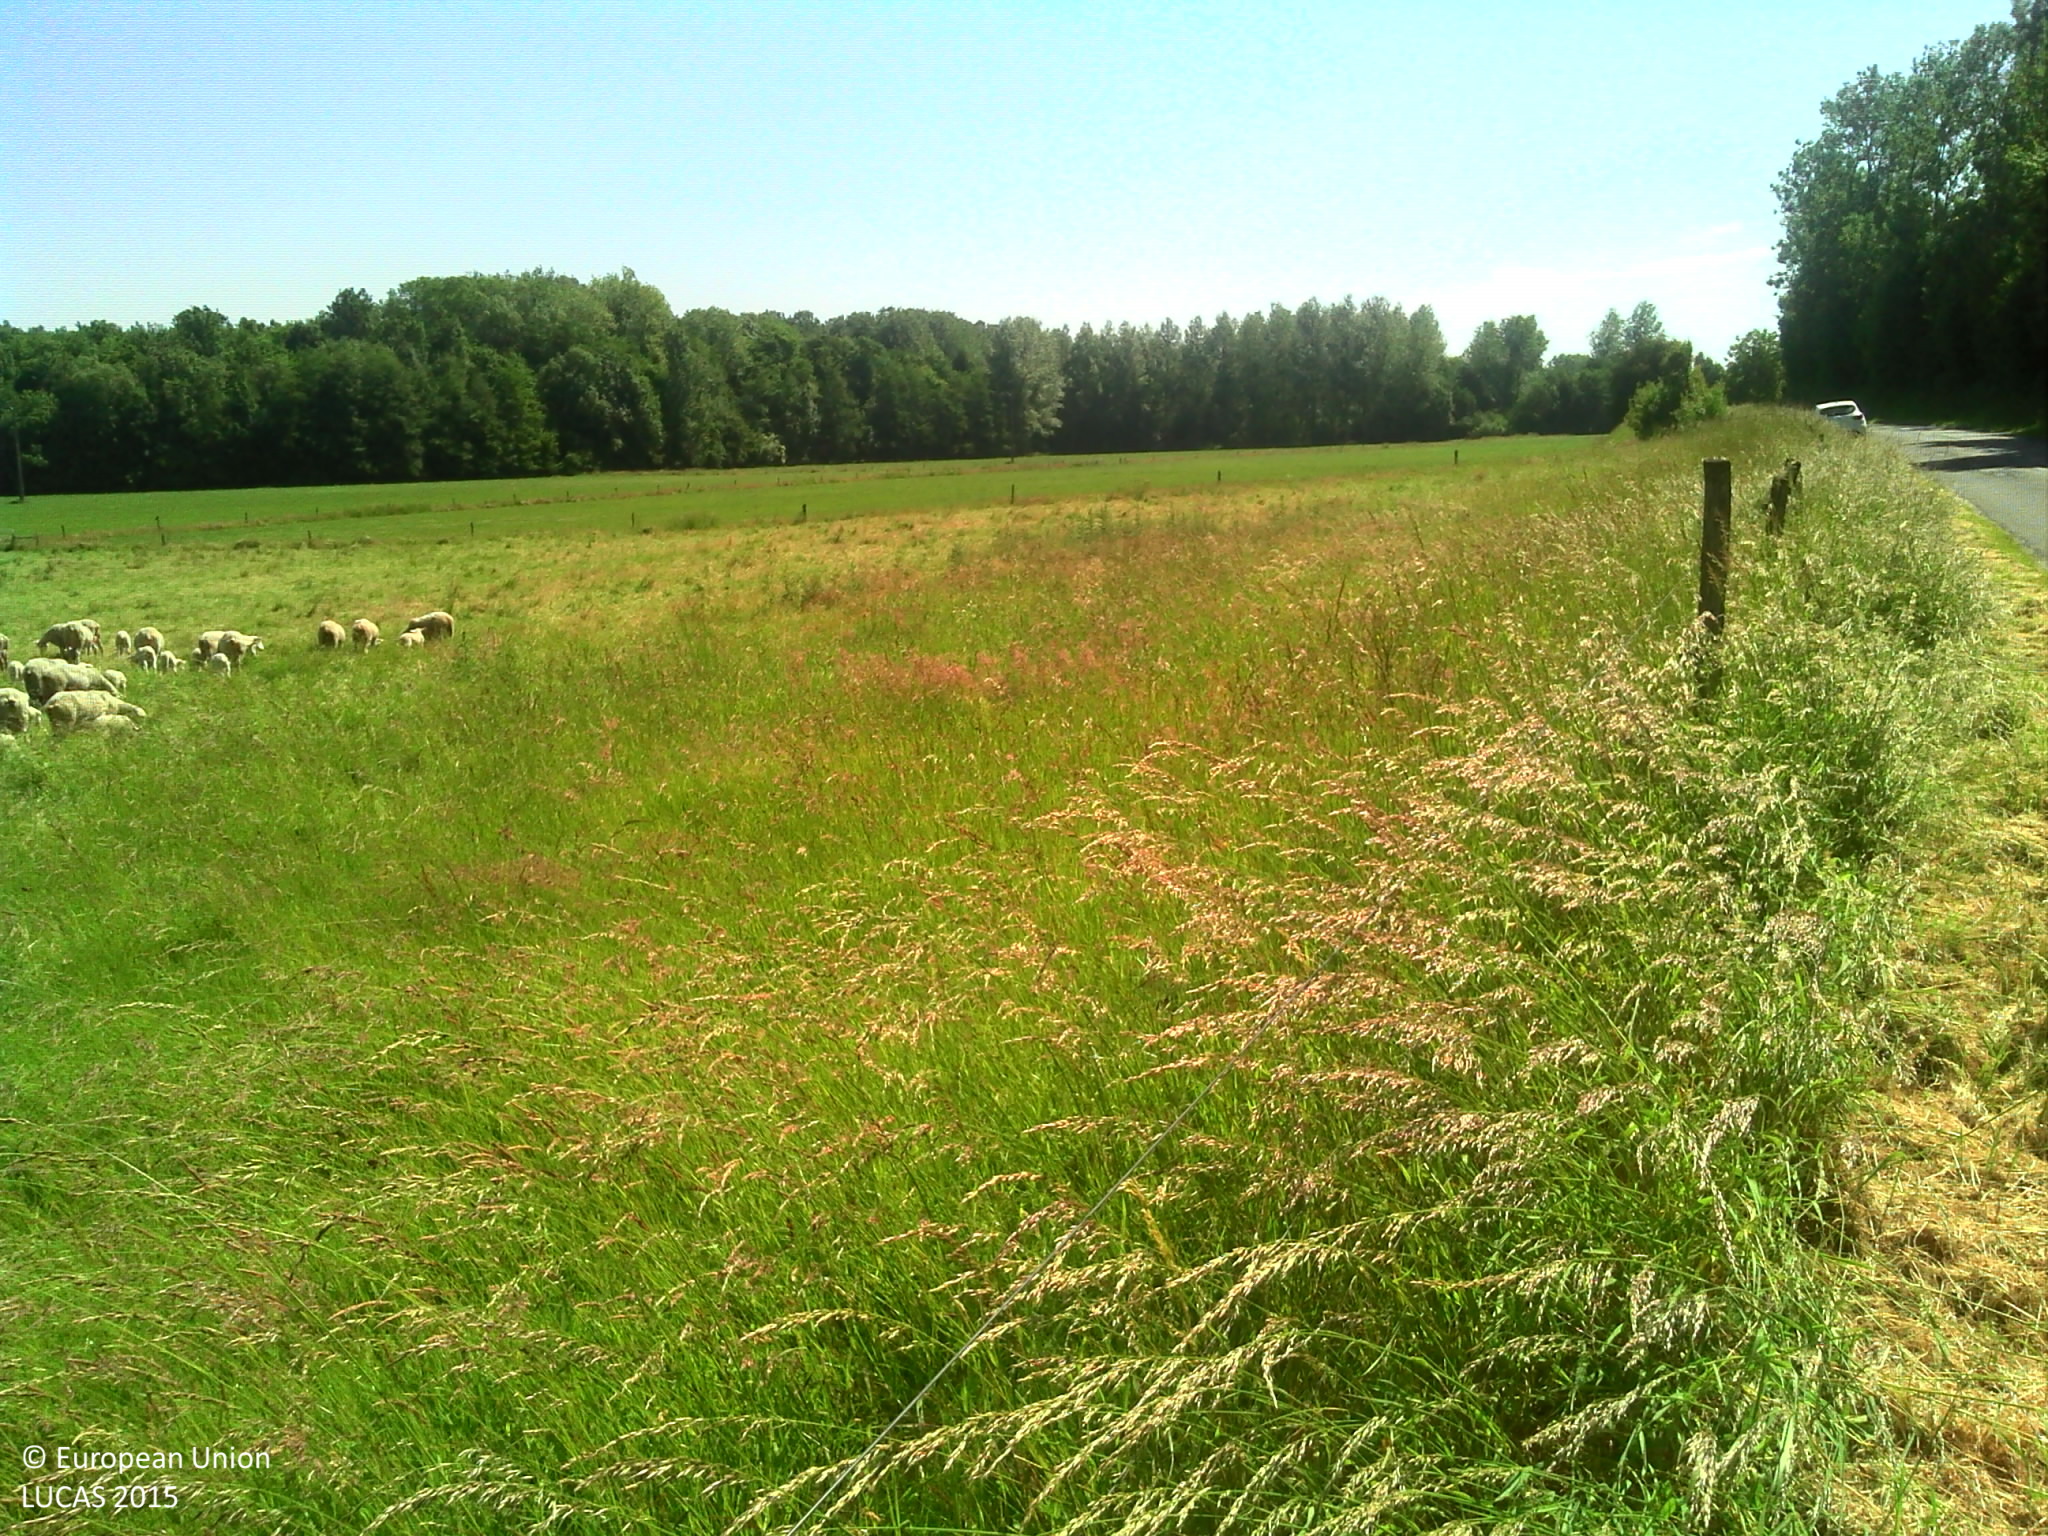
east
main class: Grassland
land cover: Grassland without tree/shrub cover
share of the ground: > 75 %
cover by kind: herbaceous plants 100 %
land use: Agriculture (excluding fallow land and kitchen gardens)
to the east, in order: Grassland without tree/shrub cover; Fences; Grassland without tree/shrub cover
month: June
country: FR
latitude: 49.6697
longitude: 4.0783
